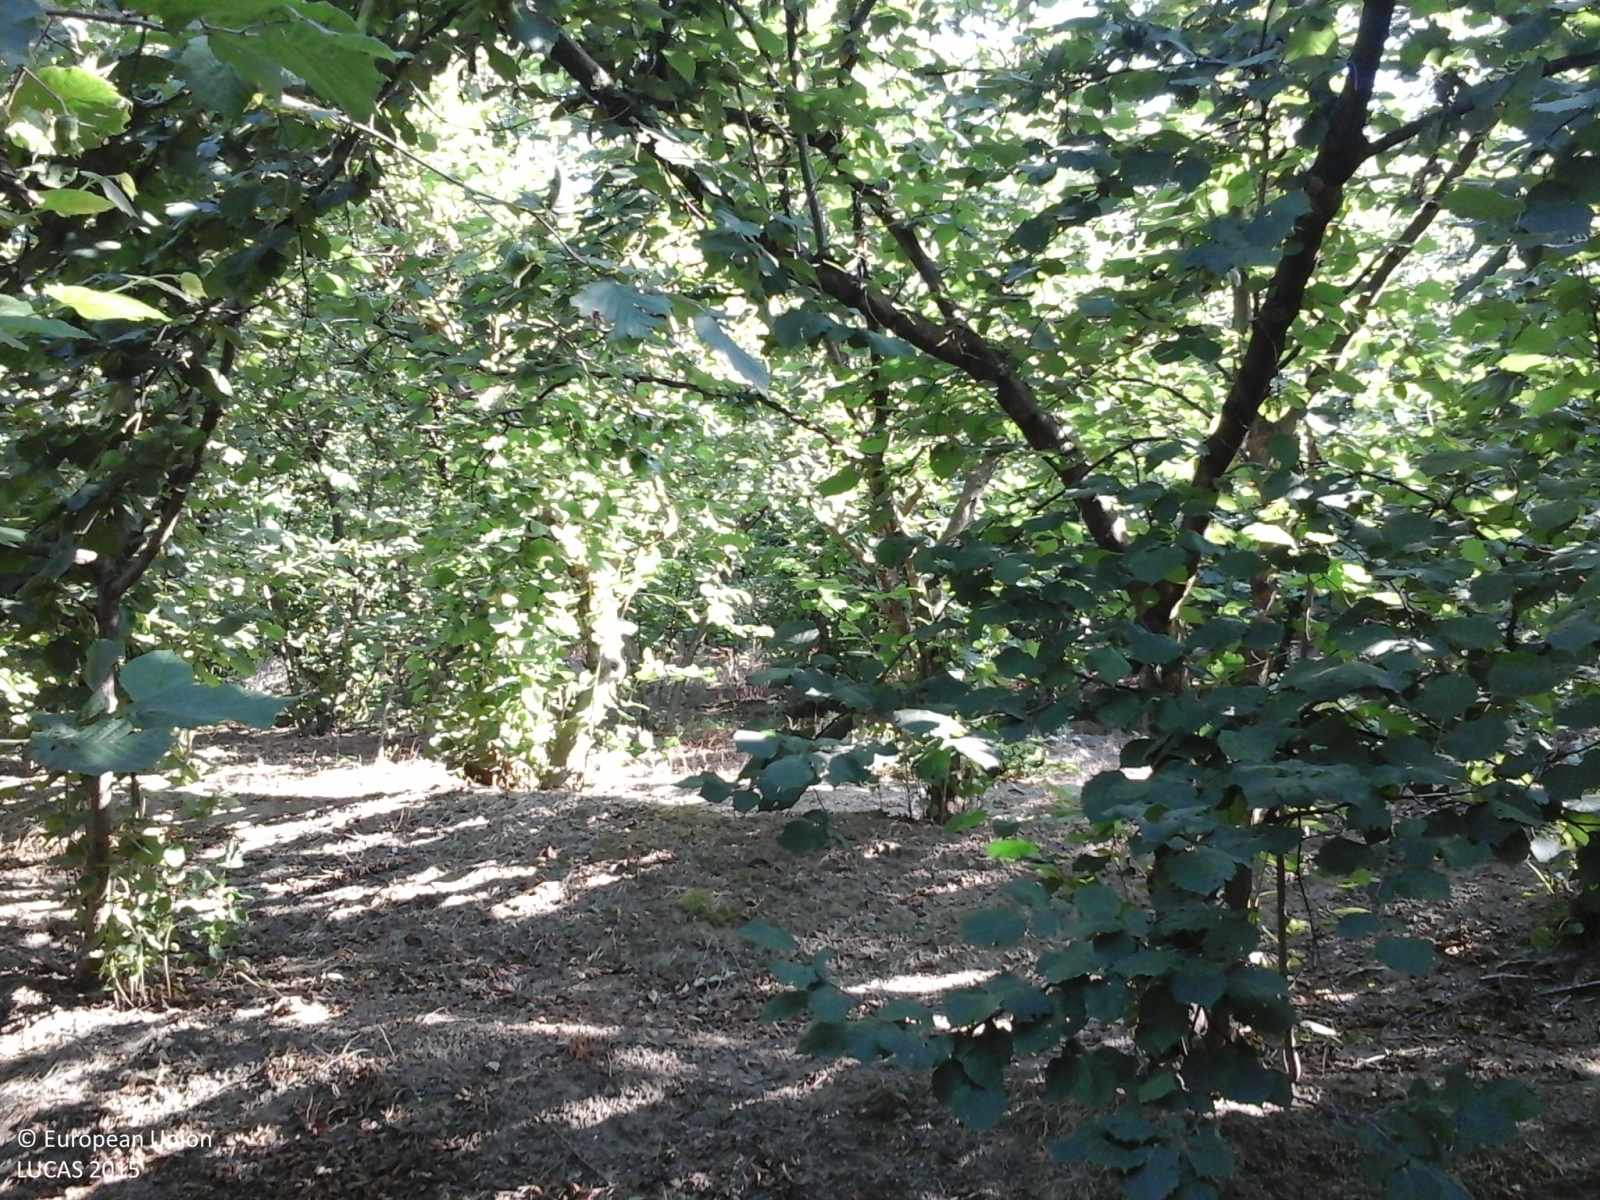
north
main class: Cropland
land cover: Nuts trees
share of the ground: > 75 %
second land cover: Other bare soil
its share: > 75 %
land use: Agriculture (excluding fallow land and kitchen gardens)
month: July
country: IT
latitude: 40.8822
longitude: 14.6451
